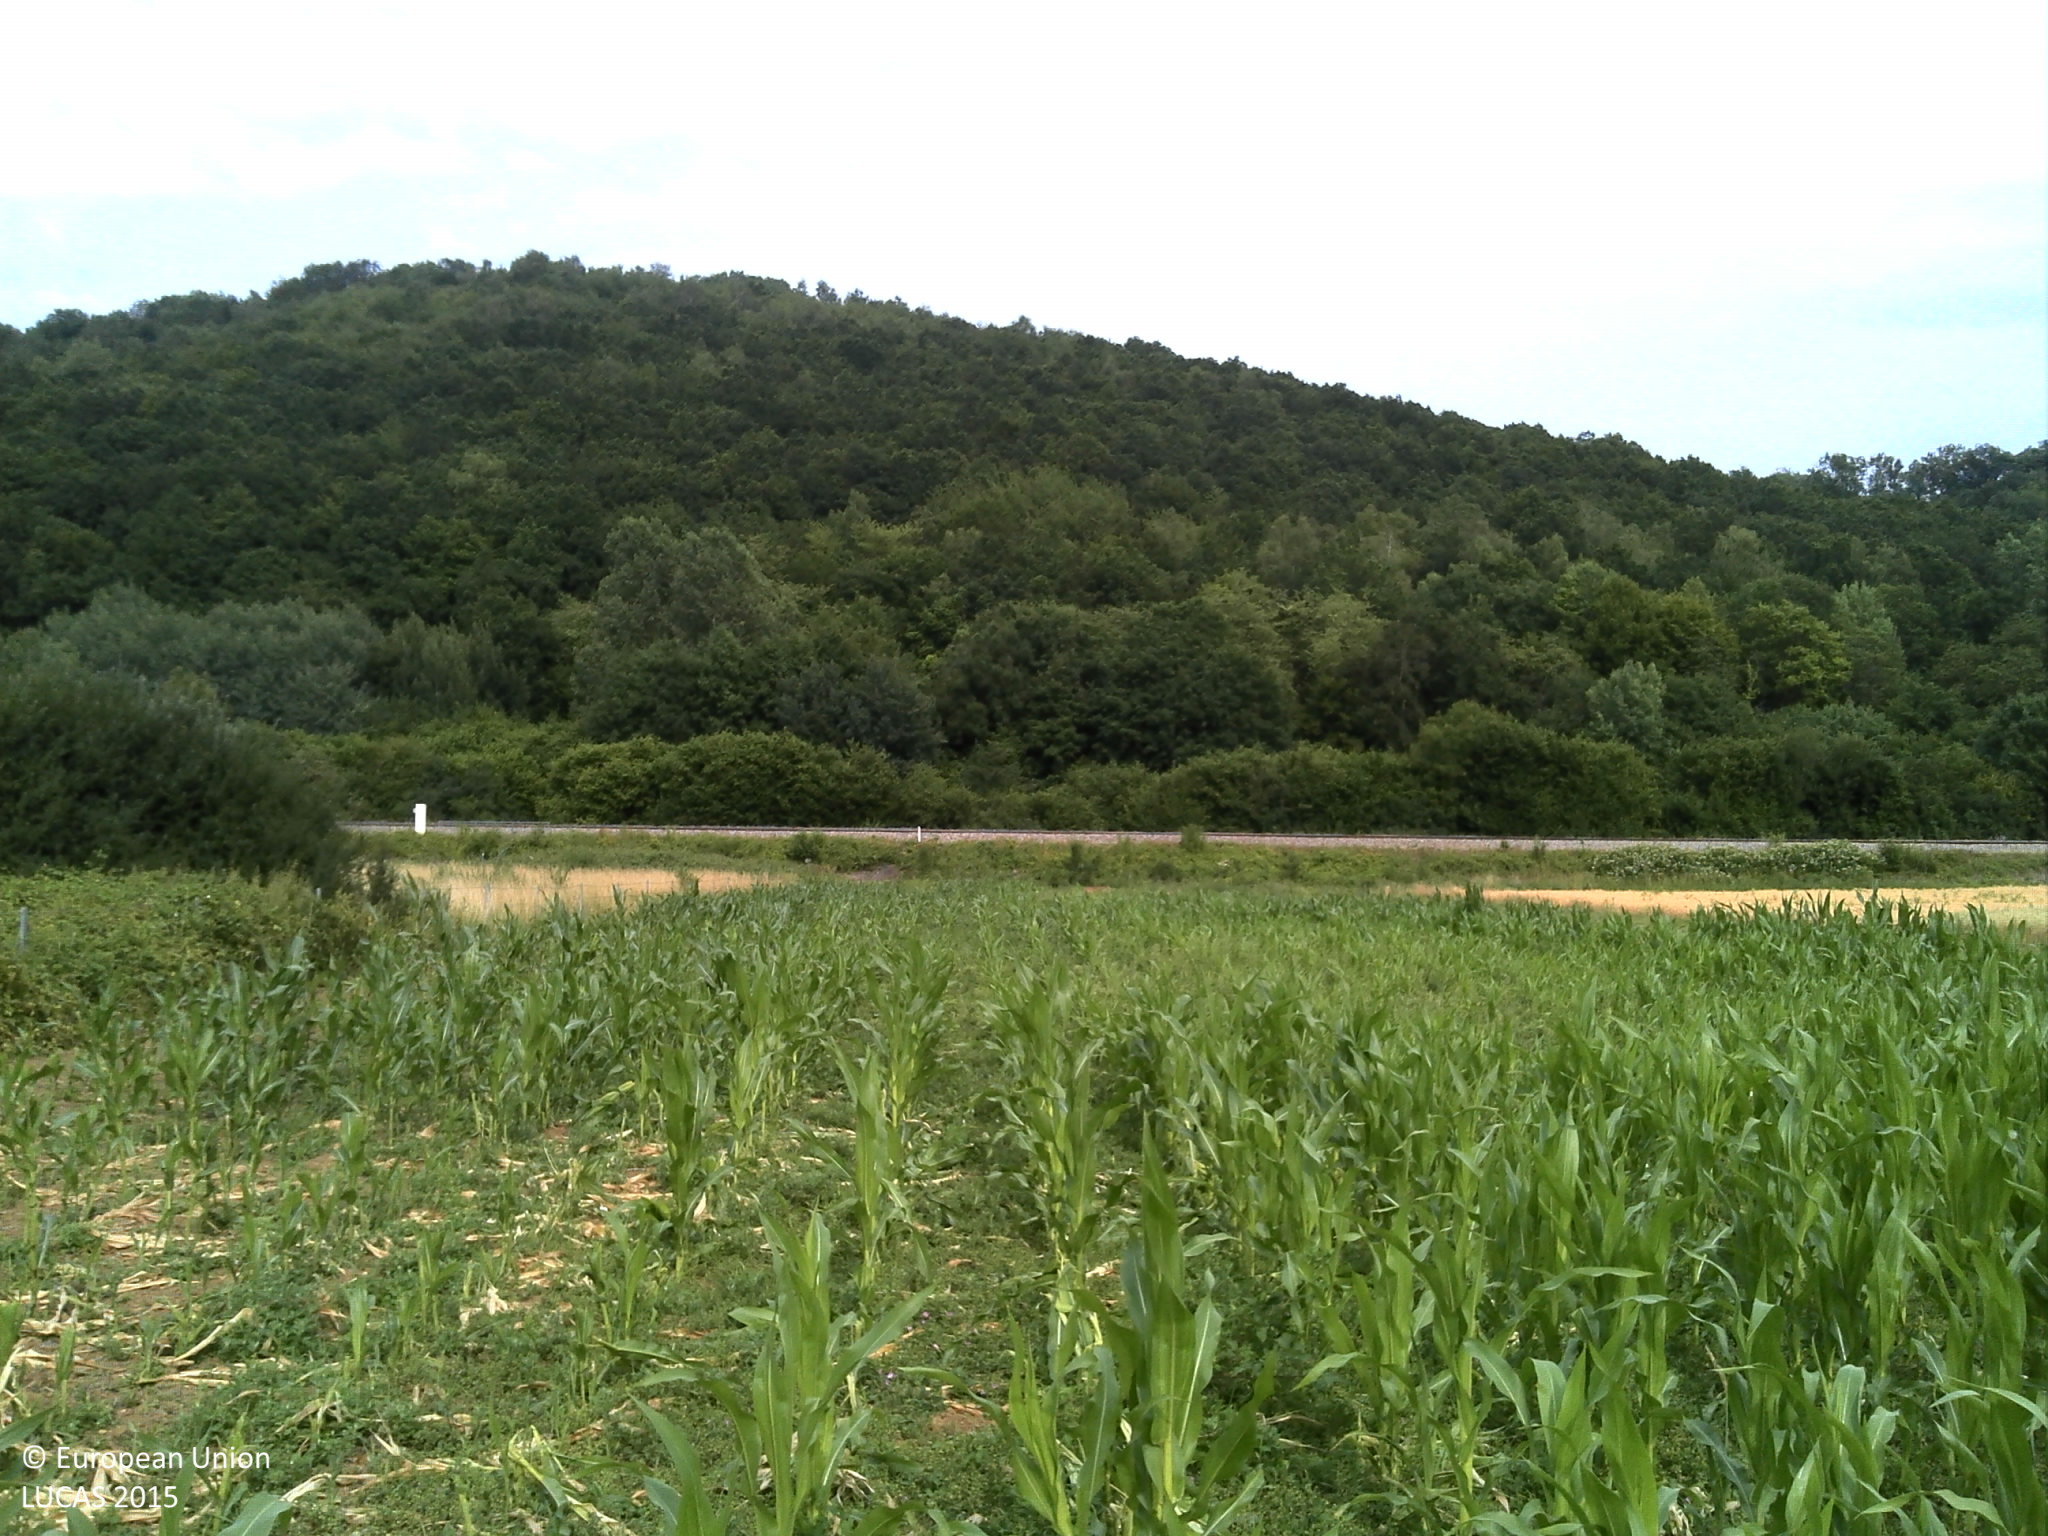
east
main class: Cropland
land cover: Maize
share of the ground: 50 - 75 %
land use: Agriculture (excluding fallow land and kitchen gardens)
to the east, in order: Maize; Shrubland without tree cover; Railways; Broadleaved woodland; Grassland without tree/shrub cover; Broadleaved woodland; Paved roads, cycling and walking lanes; Electric lines; Broadleaved woodland
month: July
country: FR
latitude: 49.7935
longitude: 4.7597
